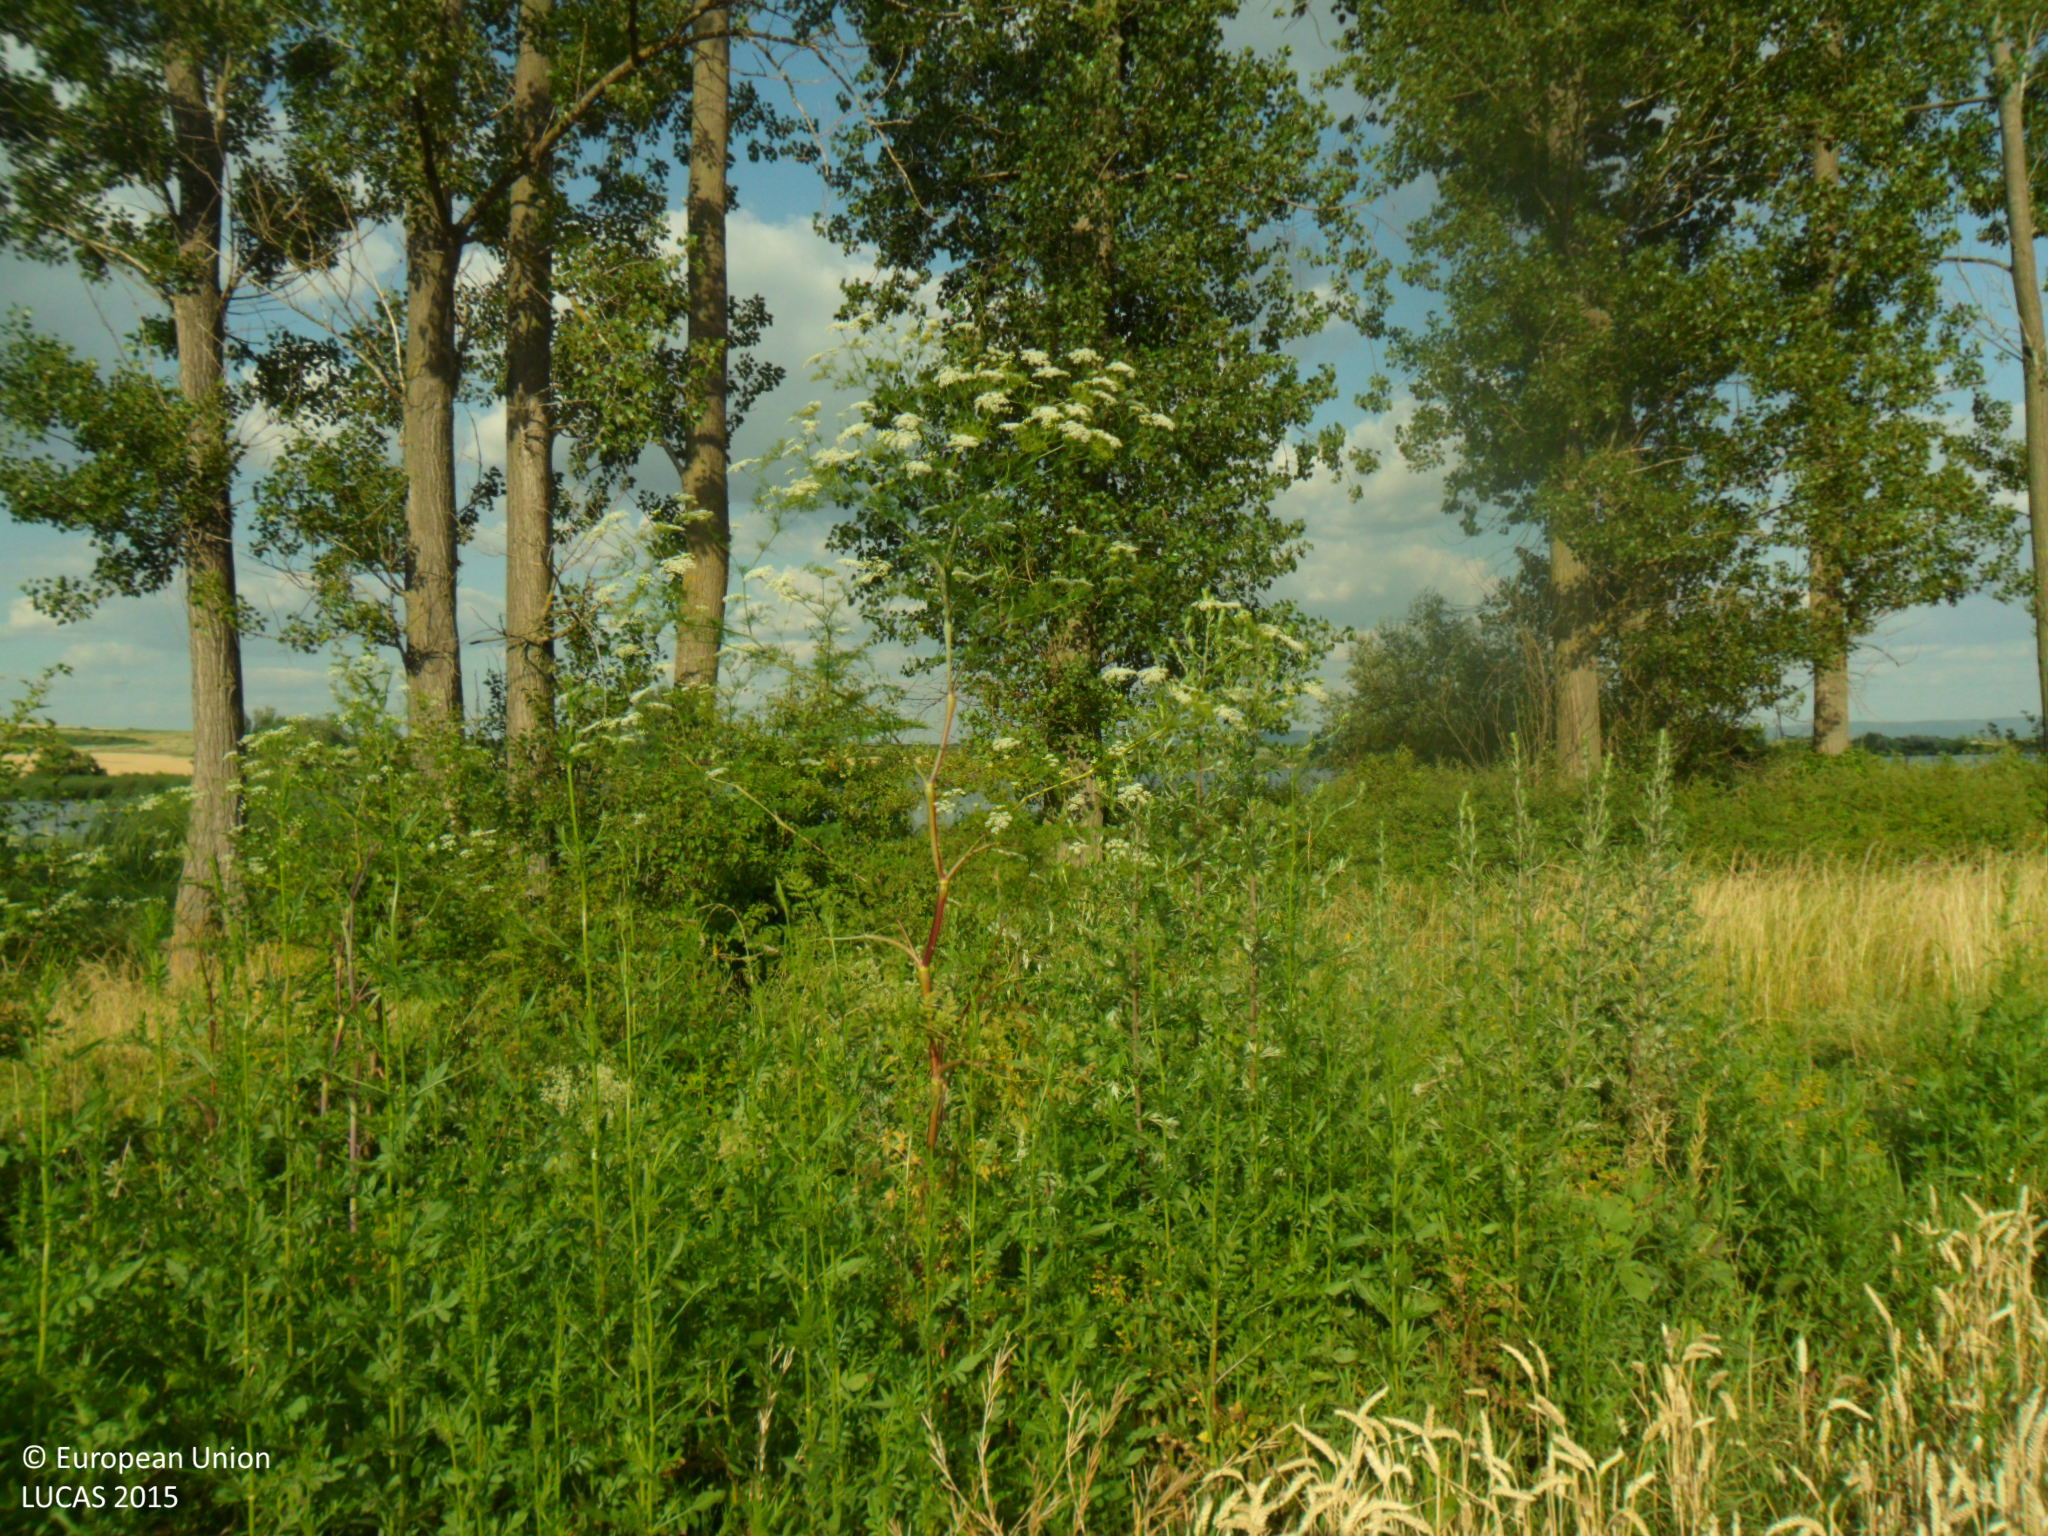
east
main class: Cropland
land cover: Common wheat
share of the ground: > 75 %
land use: Agriculture (excluding fallow land and kitchen gardens)
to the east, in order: Common wheat; Tracks; Grassland without tree/shrub cover; Lines of trees; Grassland without tree/shrub cover; Inland fresh water bodies
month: June
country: BG
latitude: 43.2211
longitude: 26.9415
